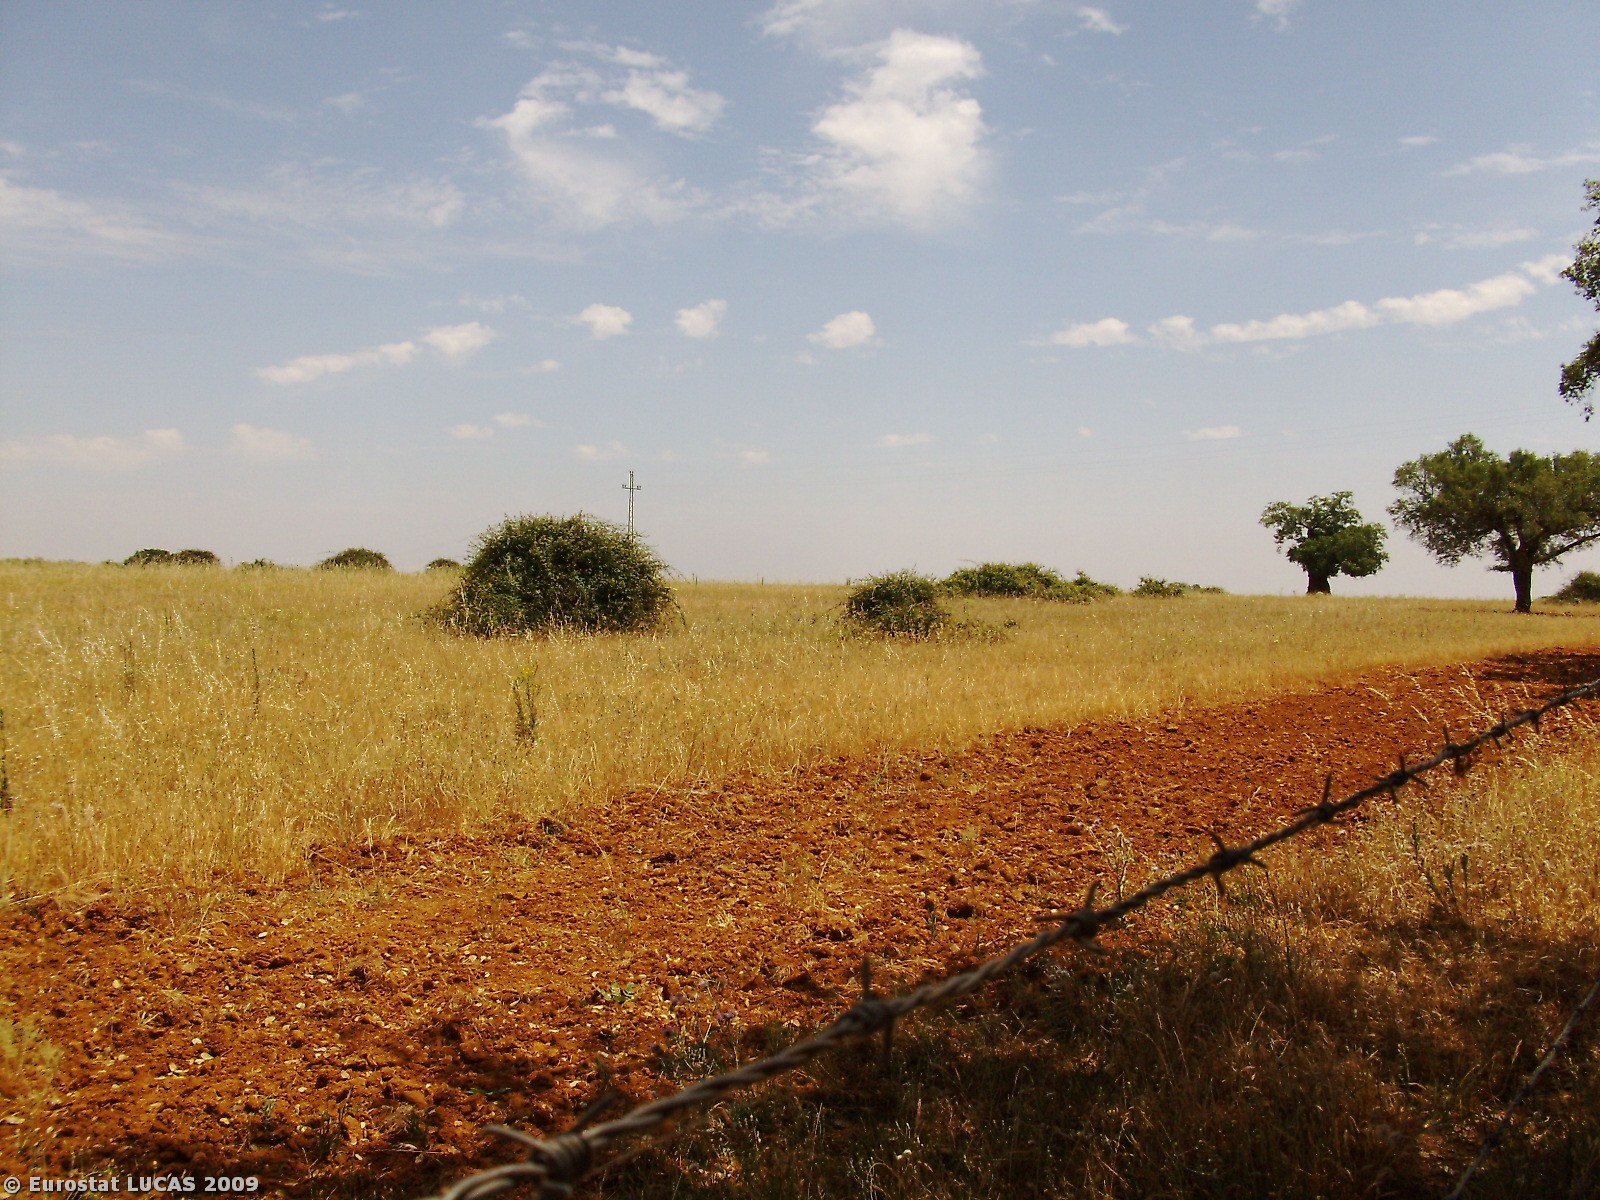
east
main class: Grassland
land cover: Grassland with sparse tree/shrub cover
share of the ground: 50 - 75 %
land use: Fallow land
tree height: > 5 m
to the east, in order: Grassland with sparse tree/shrub cover; Grassland without tree/shrub cover
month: June
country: PT
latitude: 39.1453
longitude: -7.3817
